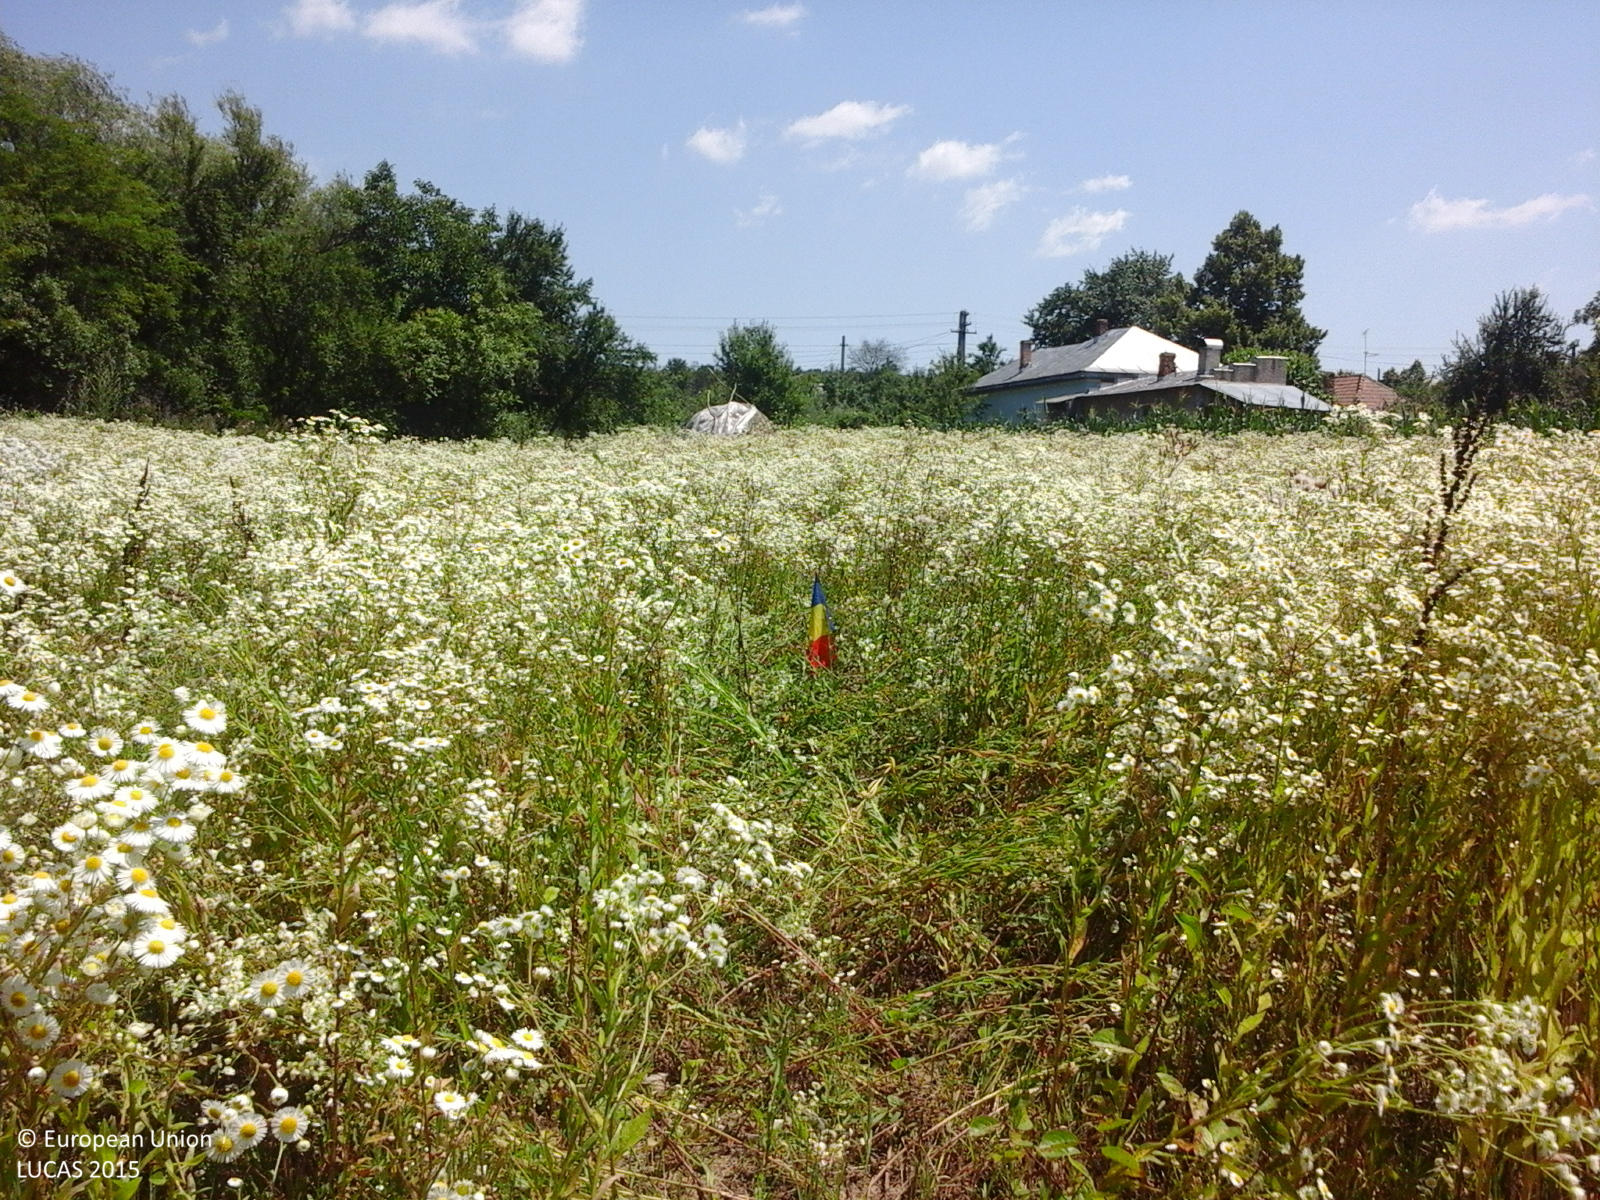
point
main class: Grassland
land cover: Spontaneously vegetated surfaces
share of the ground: > 75 %
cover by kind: herbaceous plants 100 %
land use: Agriculture (excluding fallow land and kitchen gardens)
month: July
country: RO
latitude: 44.6419
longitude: 24.3796
